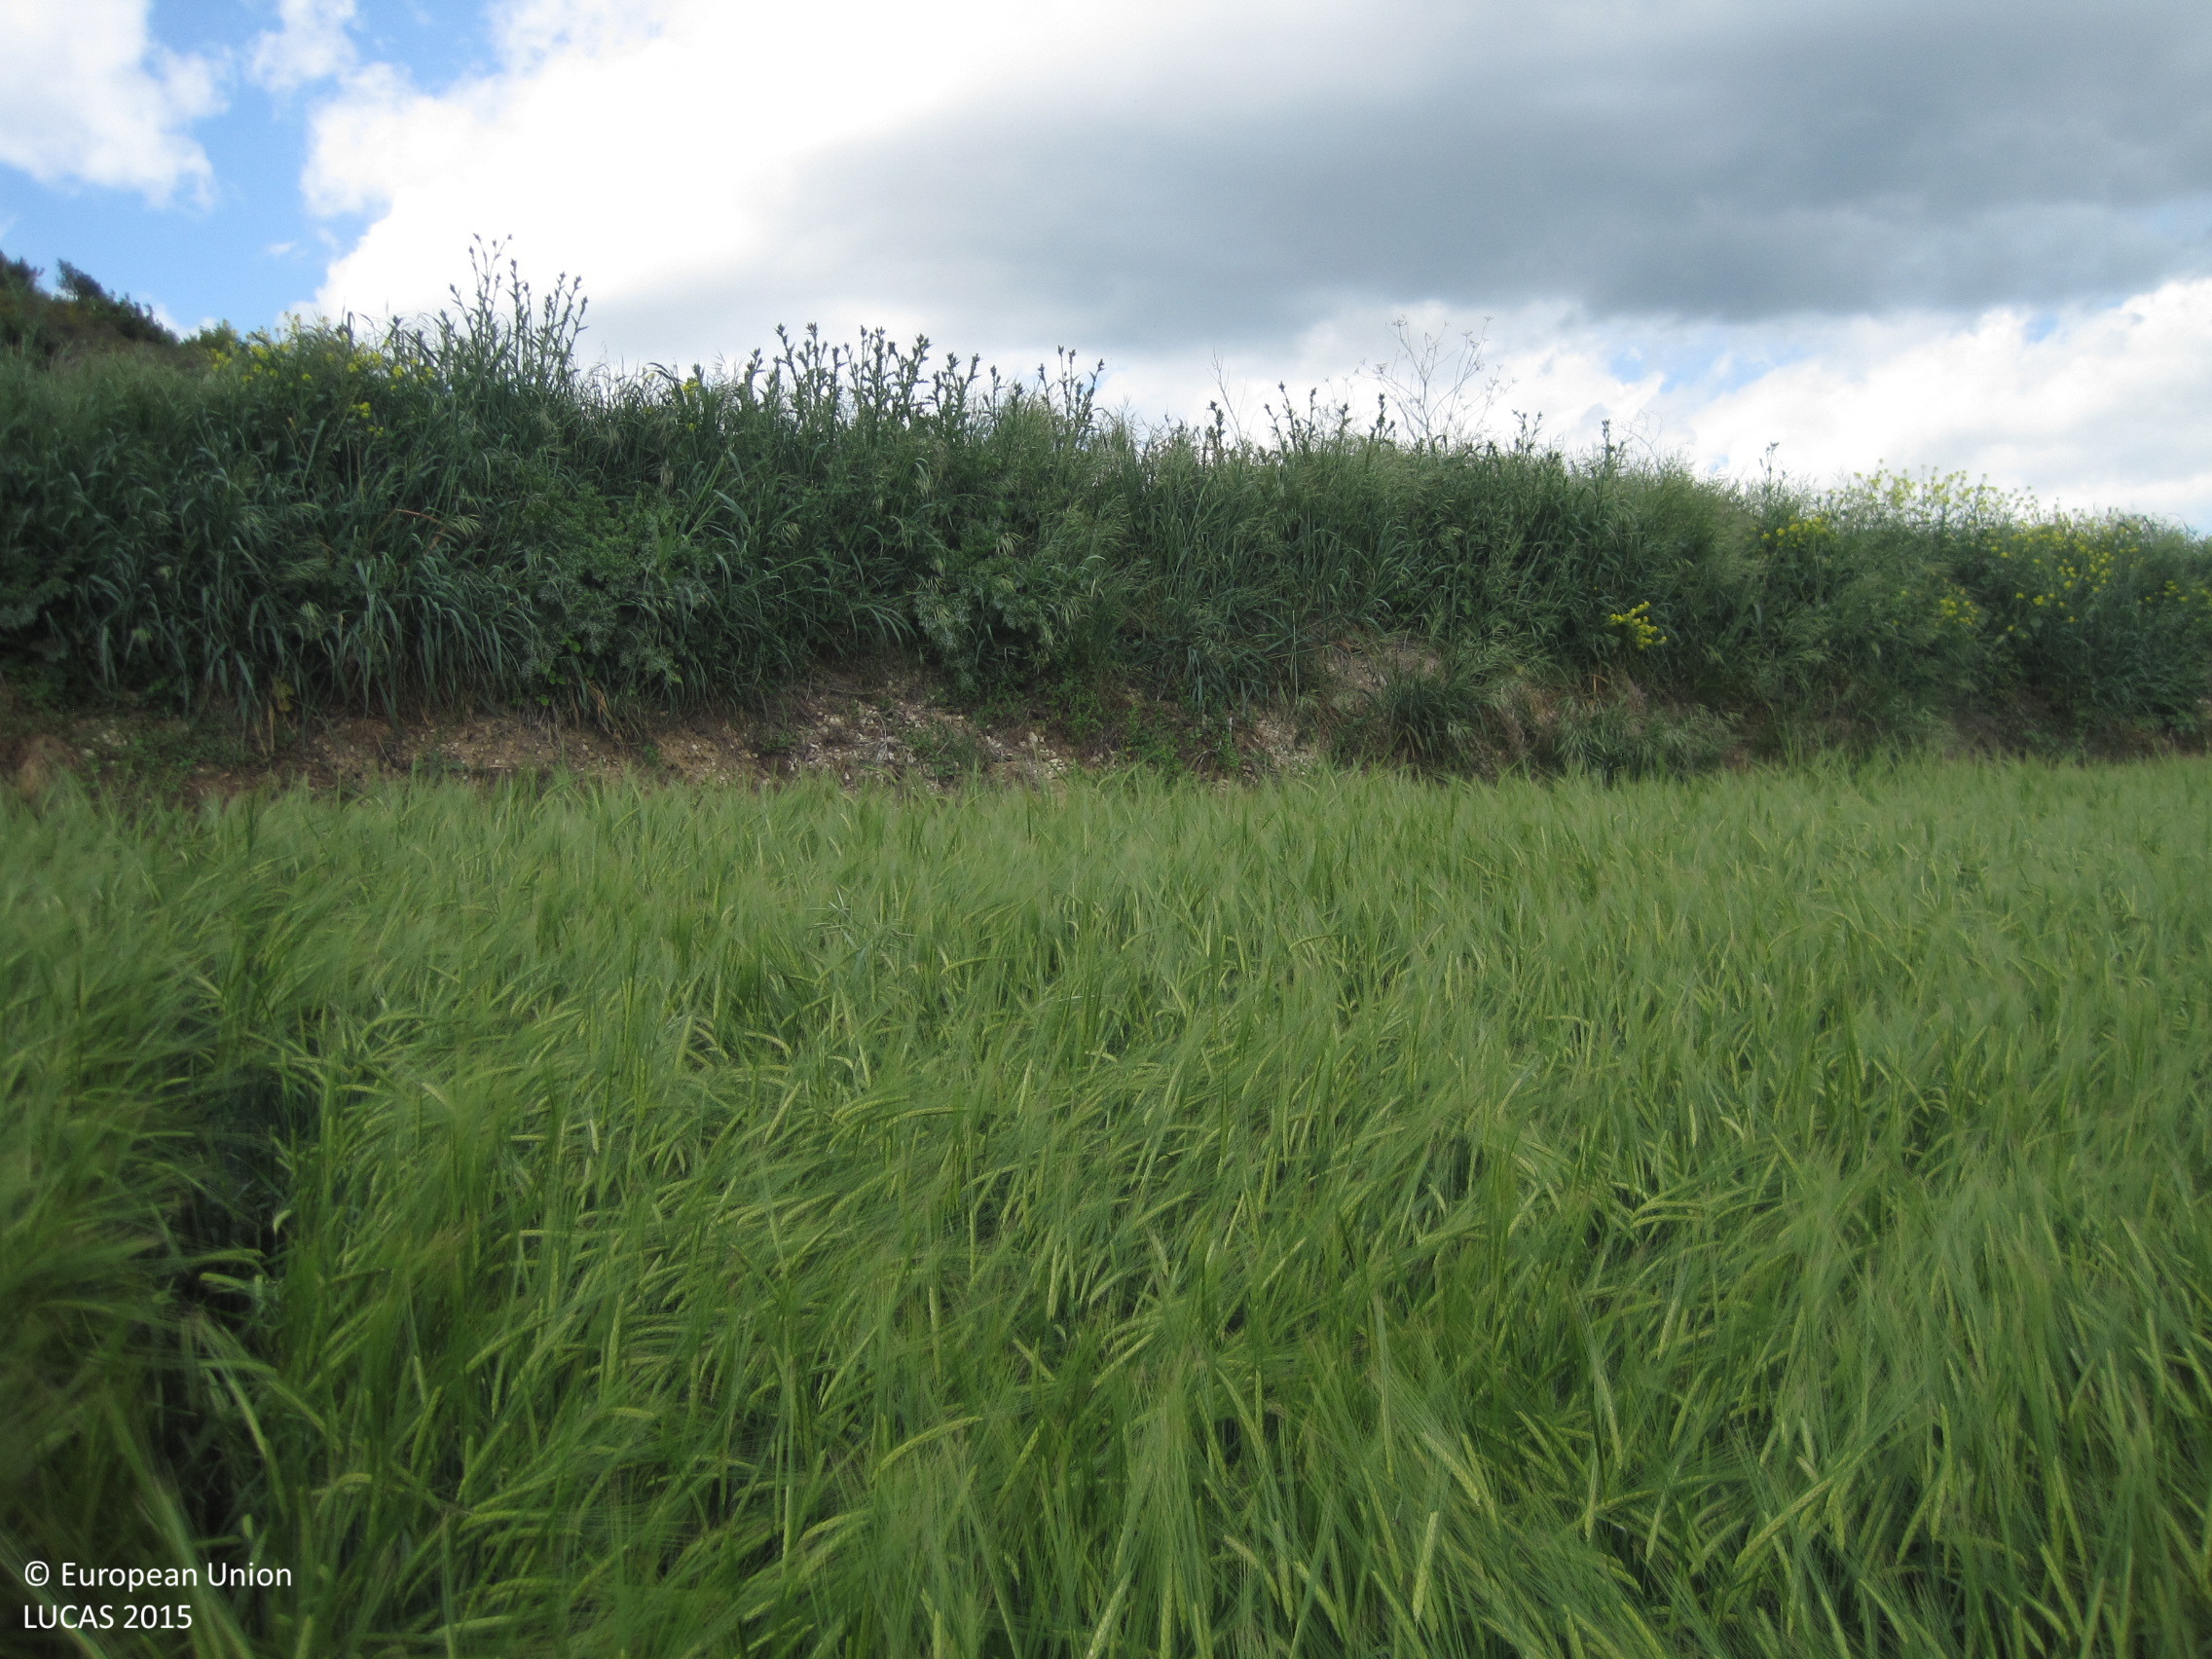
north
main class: Cropland
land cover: Barley
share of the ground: > 75 %
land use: Agriculture (excluding fallow land and kitchen gardens)
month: May
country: ES
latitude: 42.6851
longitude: -1.6938
